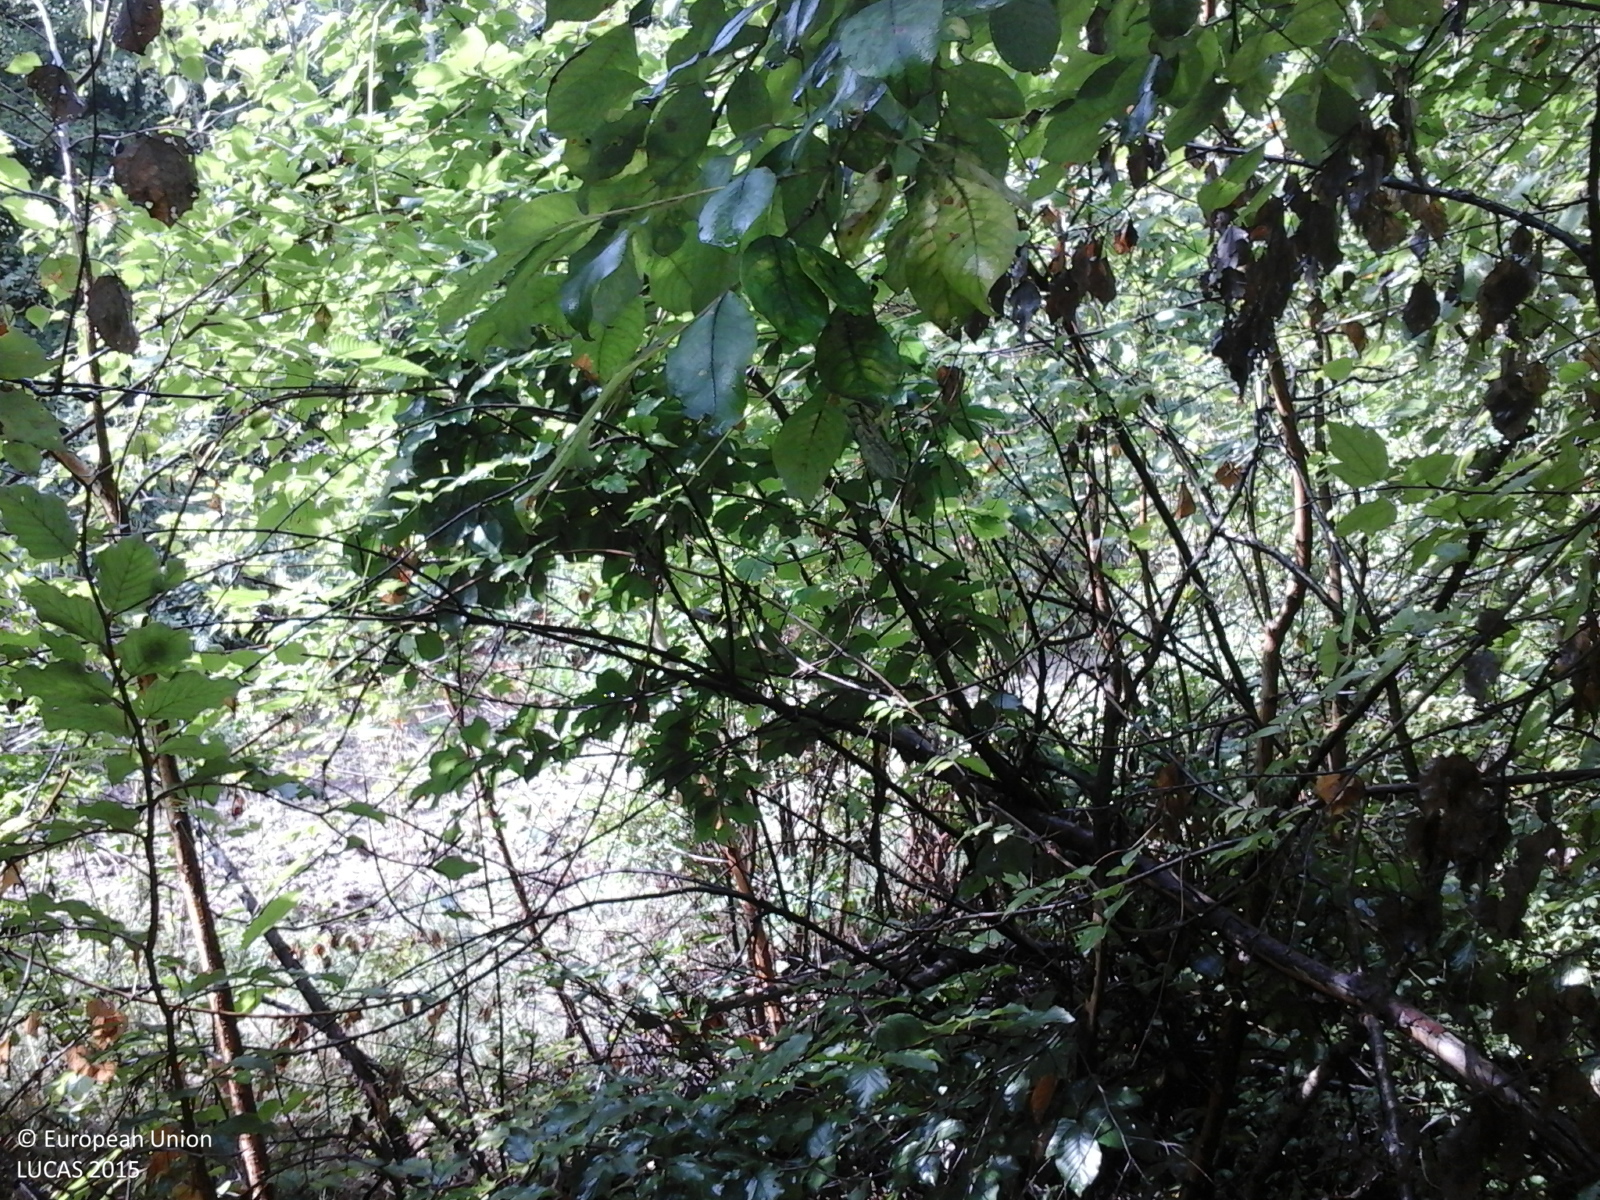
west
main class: Woodland
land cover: Broadleaved woodland
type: acidophilous oak and oak-birch forest
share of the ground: > 75 %
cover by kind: broadleaved forest trees 100 %
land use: Forestry
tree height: > 5 m
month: September
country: RO
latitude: 45.2241
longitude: 24.5328
